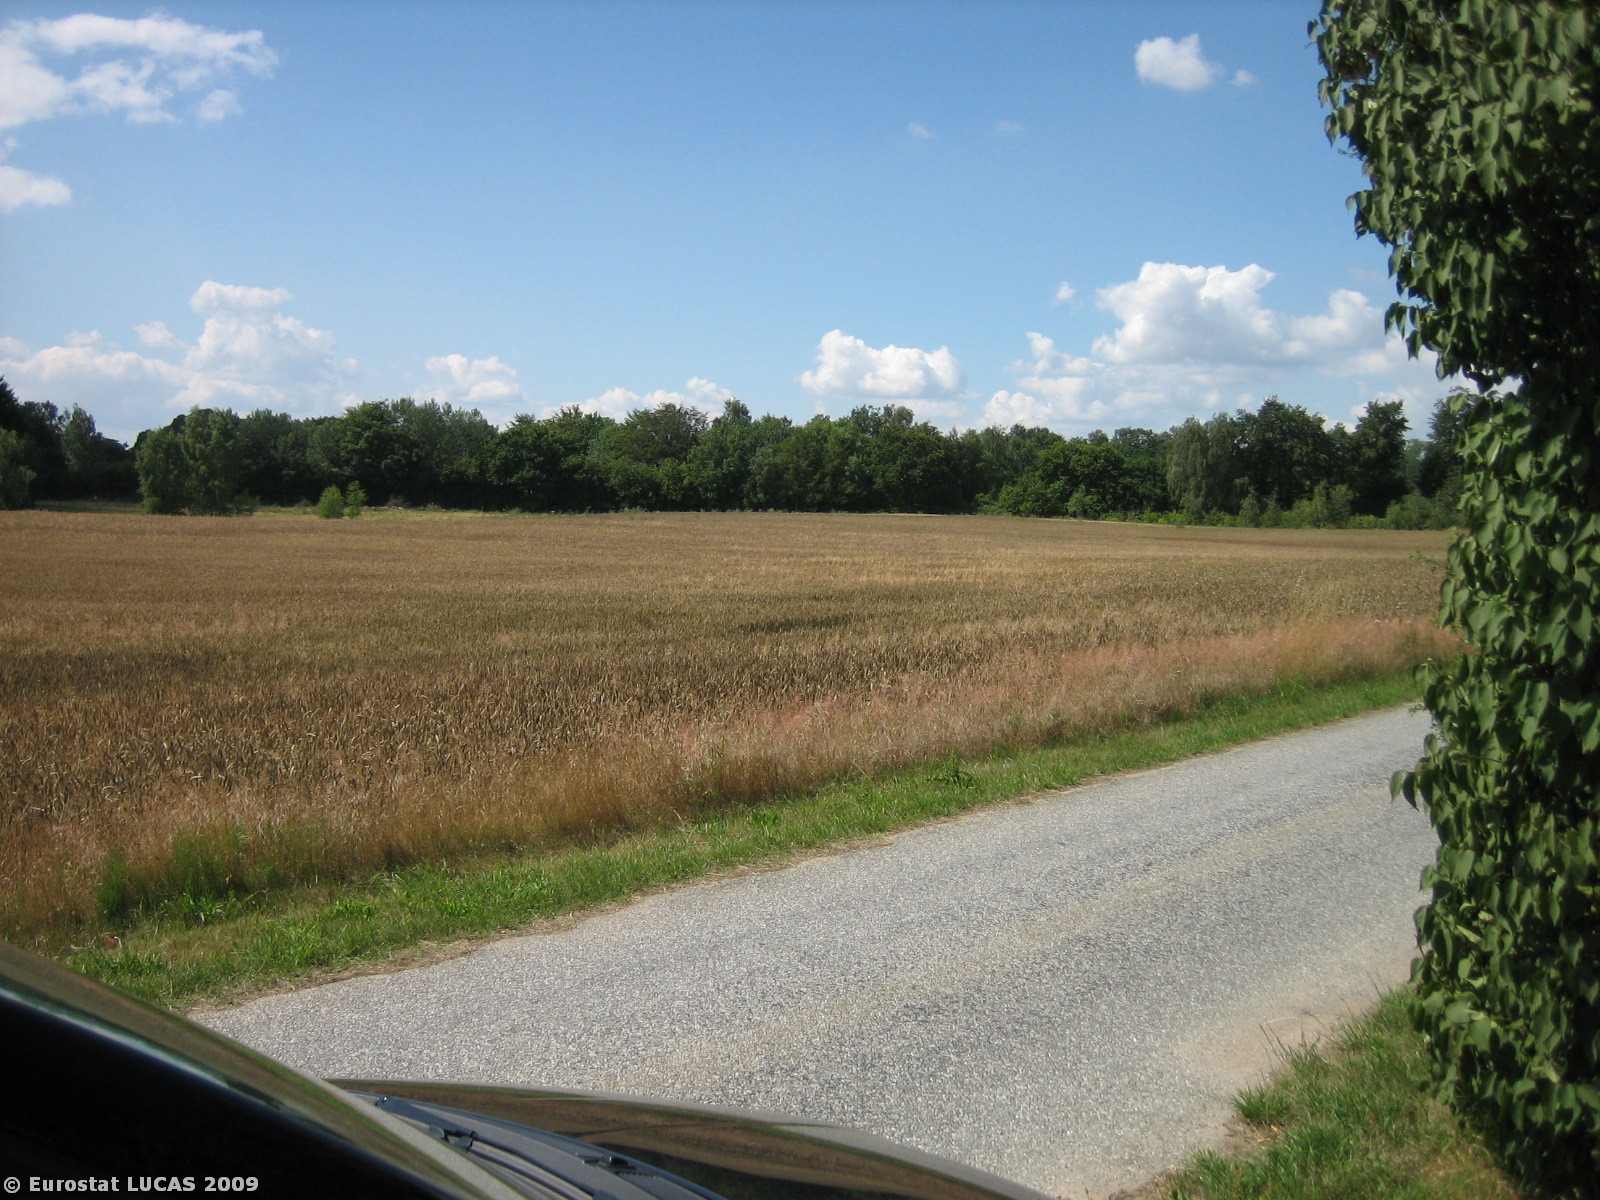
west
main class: Cropland
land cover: Rye
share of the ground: > 75 %
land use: Agriculture (excluding fallow land and kitchen gardens)
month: July
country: DK
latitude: 55.5047
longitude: 10.0158
